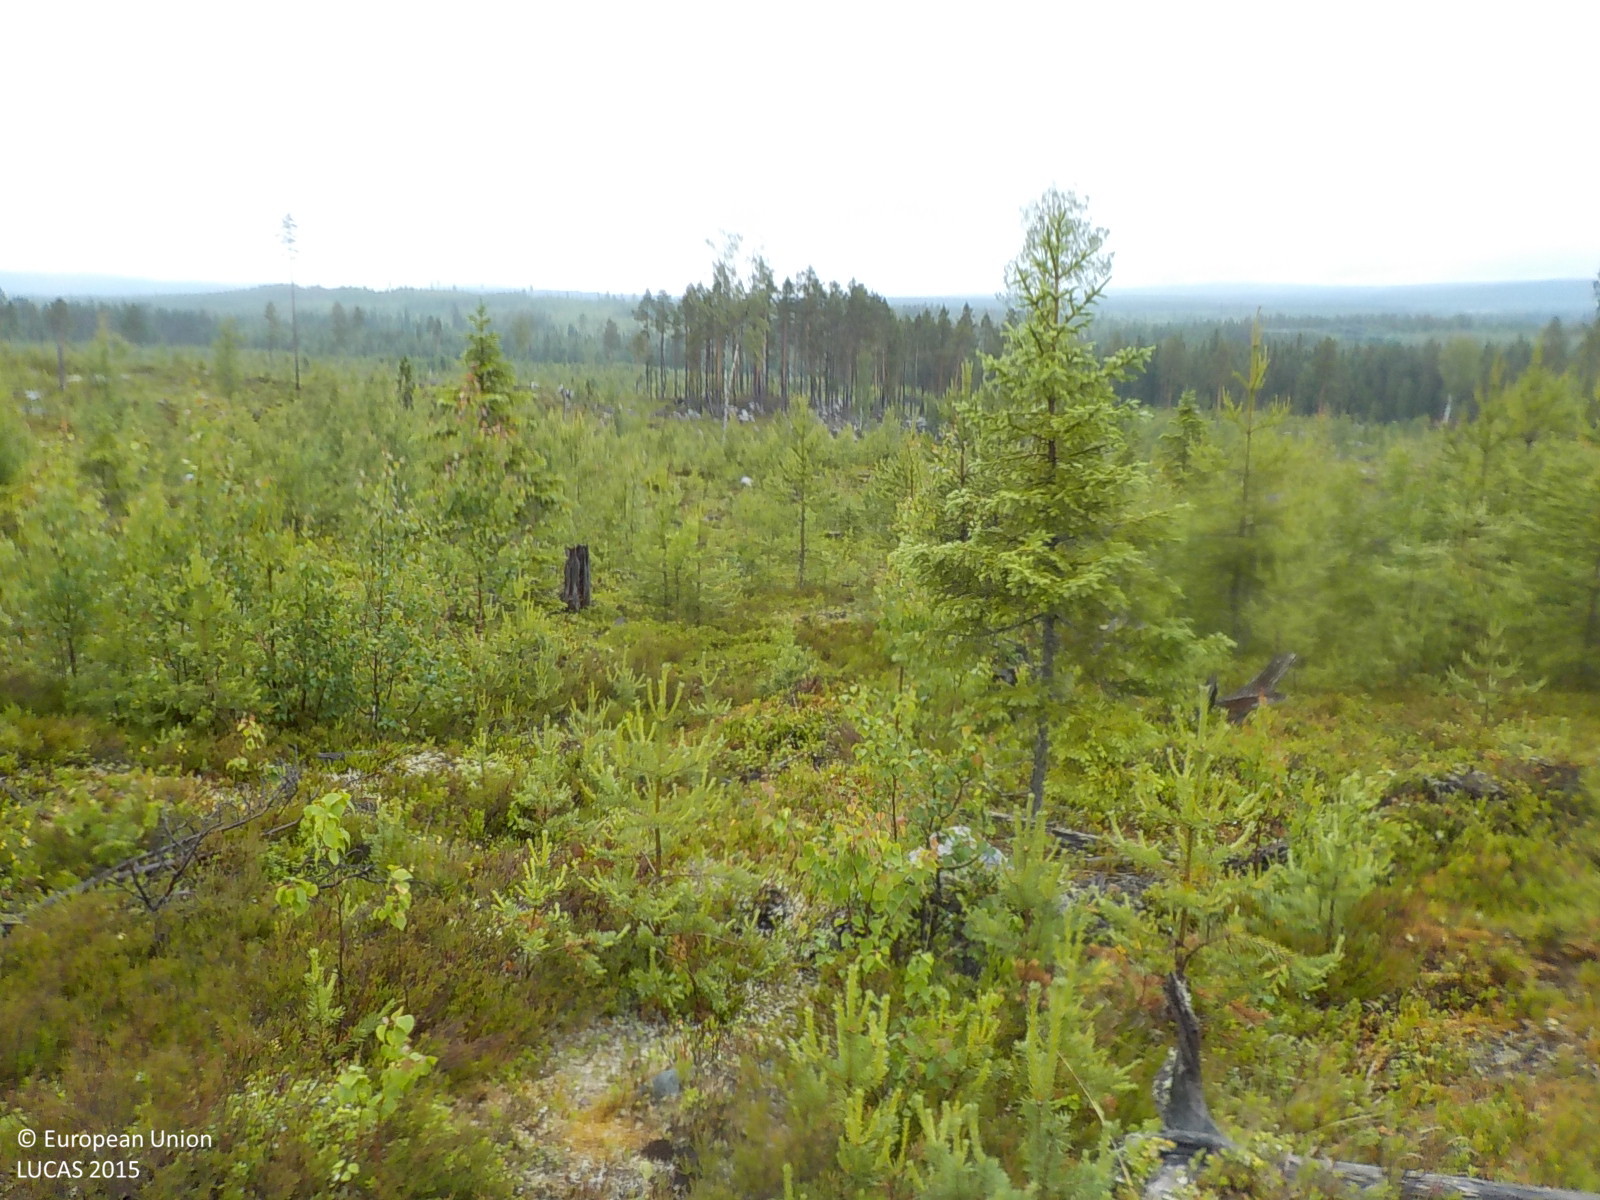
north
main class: Woodland
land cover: Other mixed woodland
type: boreal forest
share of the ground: 50 - 75 %
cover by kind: shrubs 50 %, coniferous forest trees 30 %, broadleaved forest trees 20 %
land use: Forestry
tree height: < 5 m
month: July
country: SE
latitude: 63.0116
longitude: 16.9883
